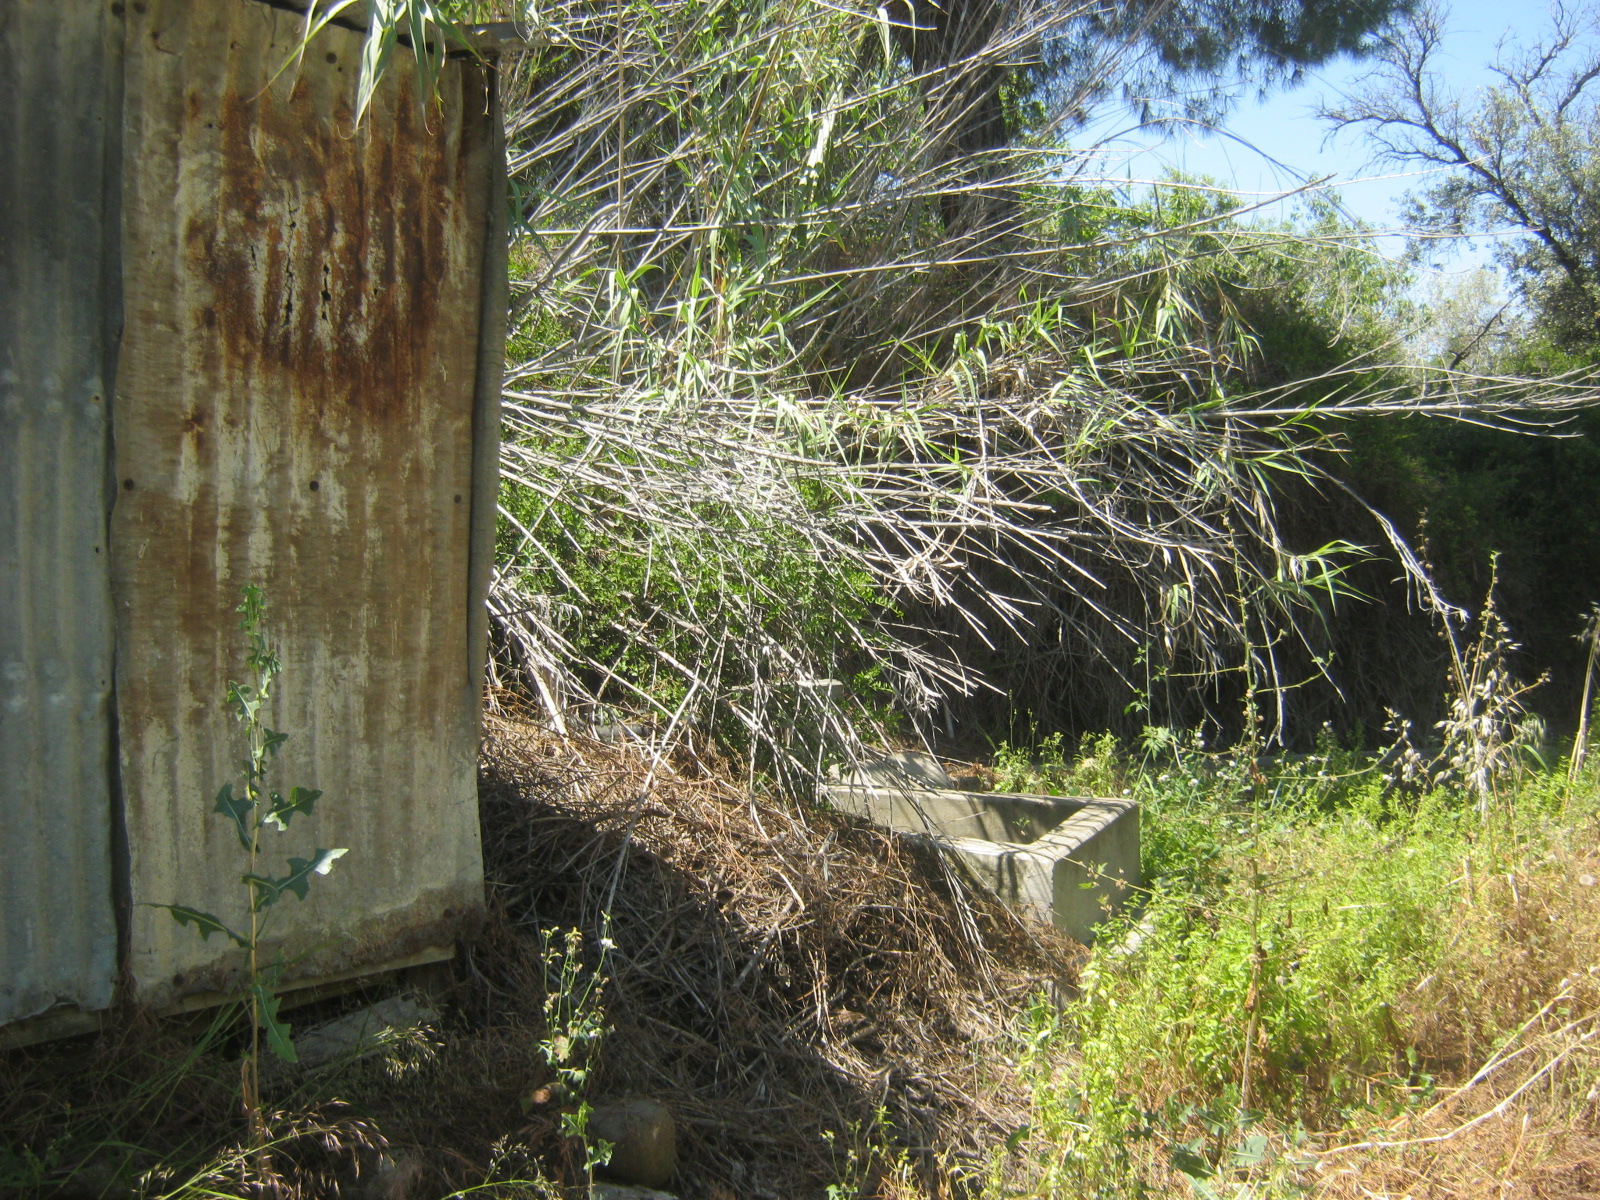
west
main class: Cropland
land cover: Other fruit trees and berries
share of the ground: > 75 %
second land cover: Other bare soil
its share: > 75 %
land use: Agriculture (excluding fallow land and kitchen gardens)
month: May
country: CY
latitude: 35.0852
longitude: 32.8873
